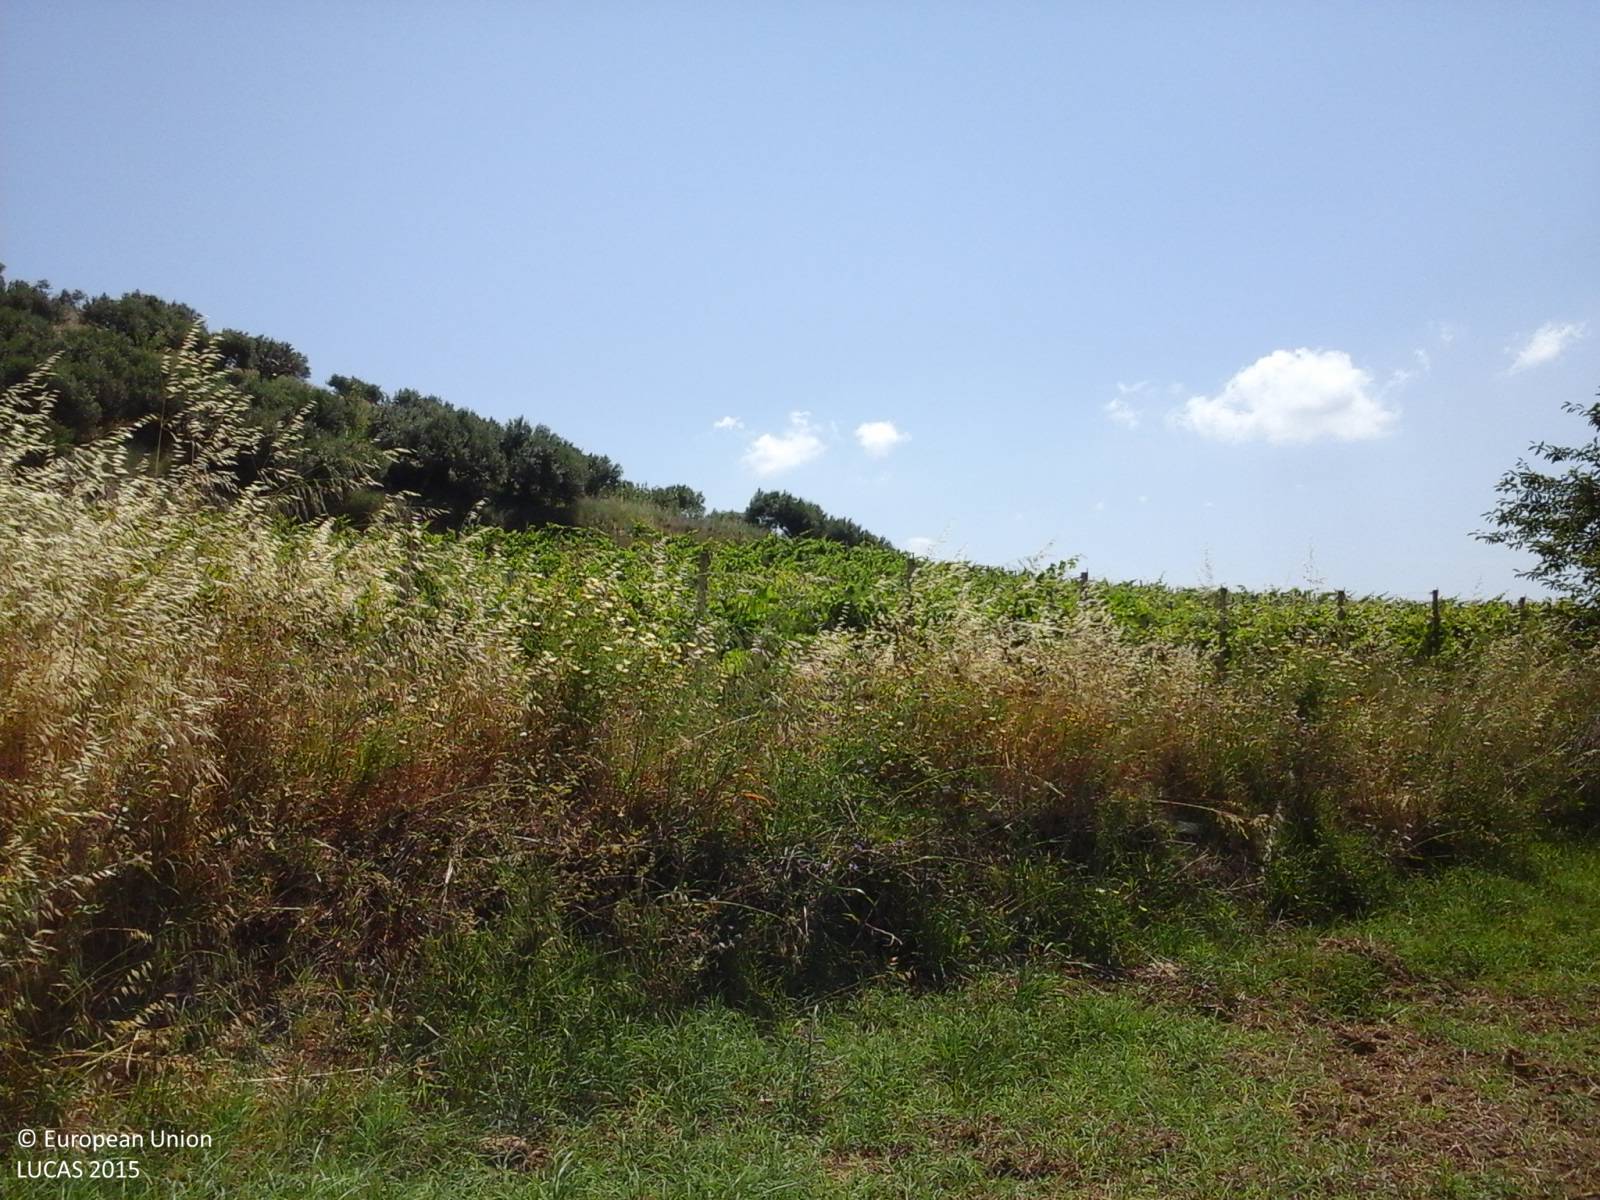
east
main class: Grassland
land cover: Spontaneously vegetated surfaces
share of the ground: > 75 %
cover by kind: herbaceous plants 100 %
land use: Agriculture (excluding fallow land and kitchen gardens)
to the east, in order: Spontaneously vegetated surfaces; Grass margins; Vineyards; Olive groves; Vineyards
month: June
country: IT
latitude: 37.9359
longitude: 13.0161
